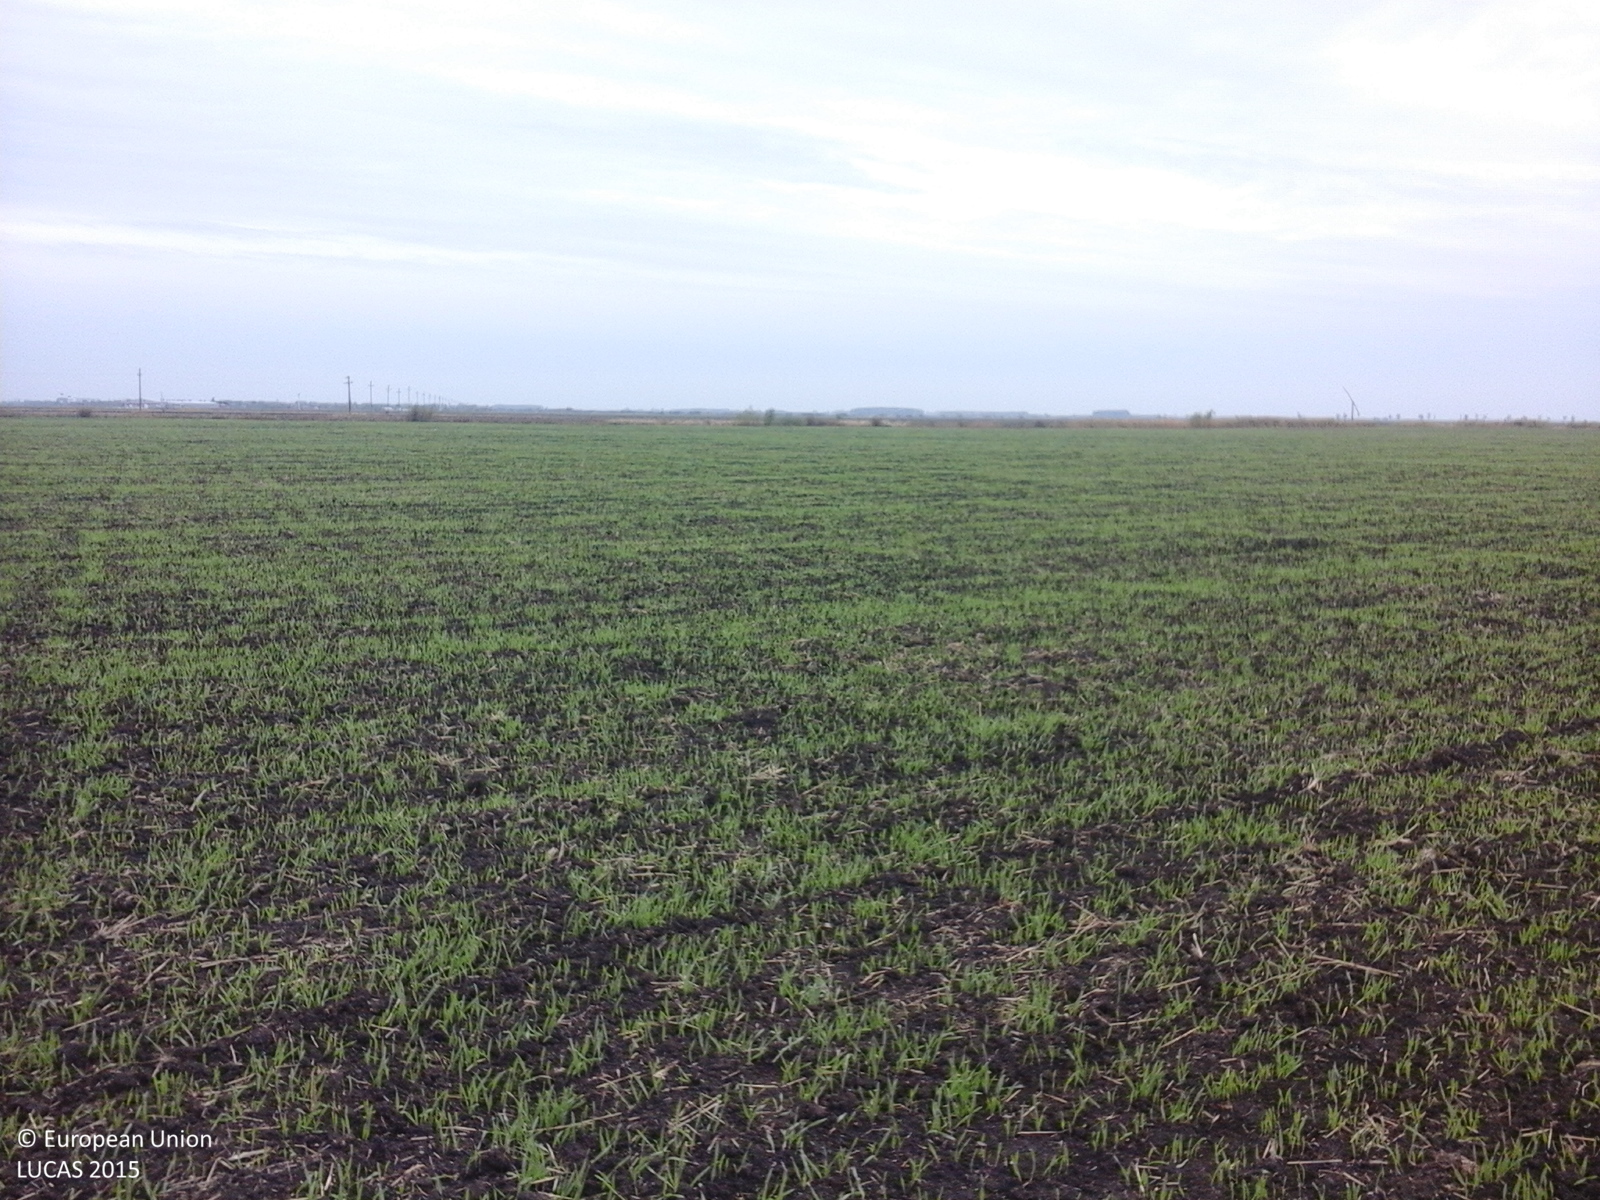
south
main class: Cropland
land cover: Common wheat
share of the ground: 50 - 75 %
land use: Agriculture (excluding fallow land and kitchen gardens)
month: October
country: RO
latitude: 44.9355
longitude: 26.3486
